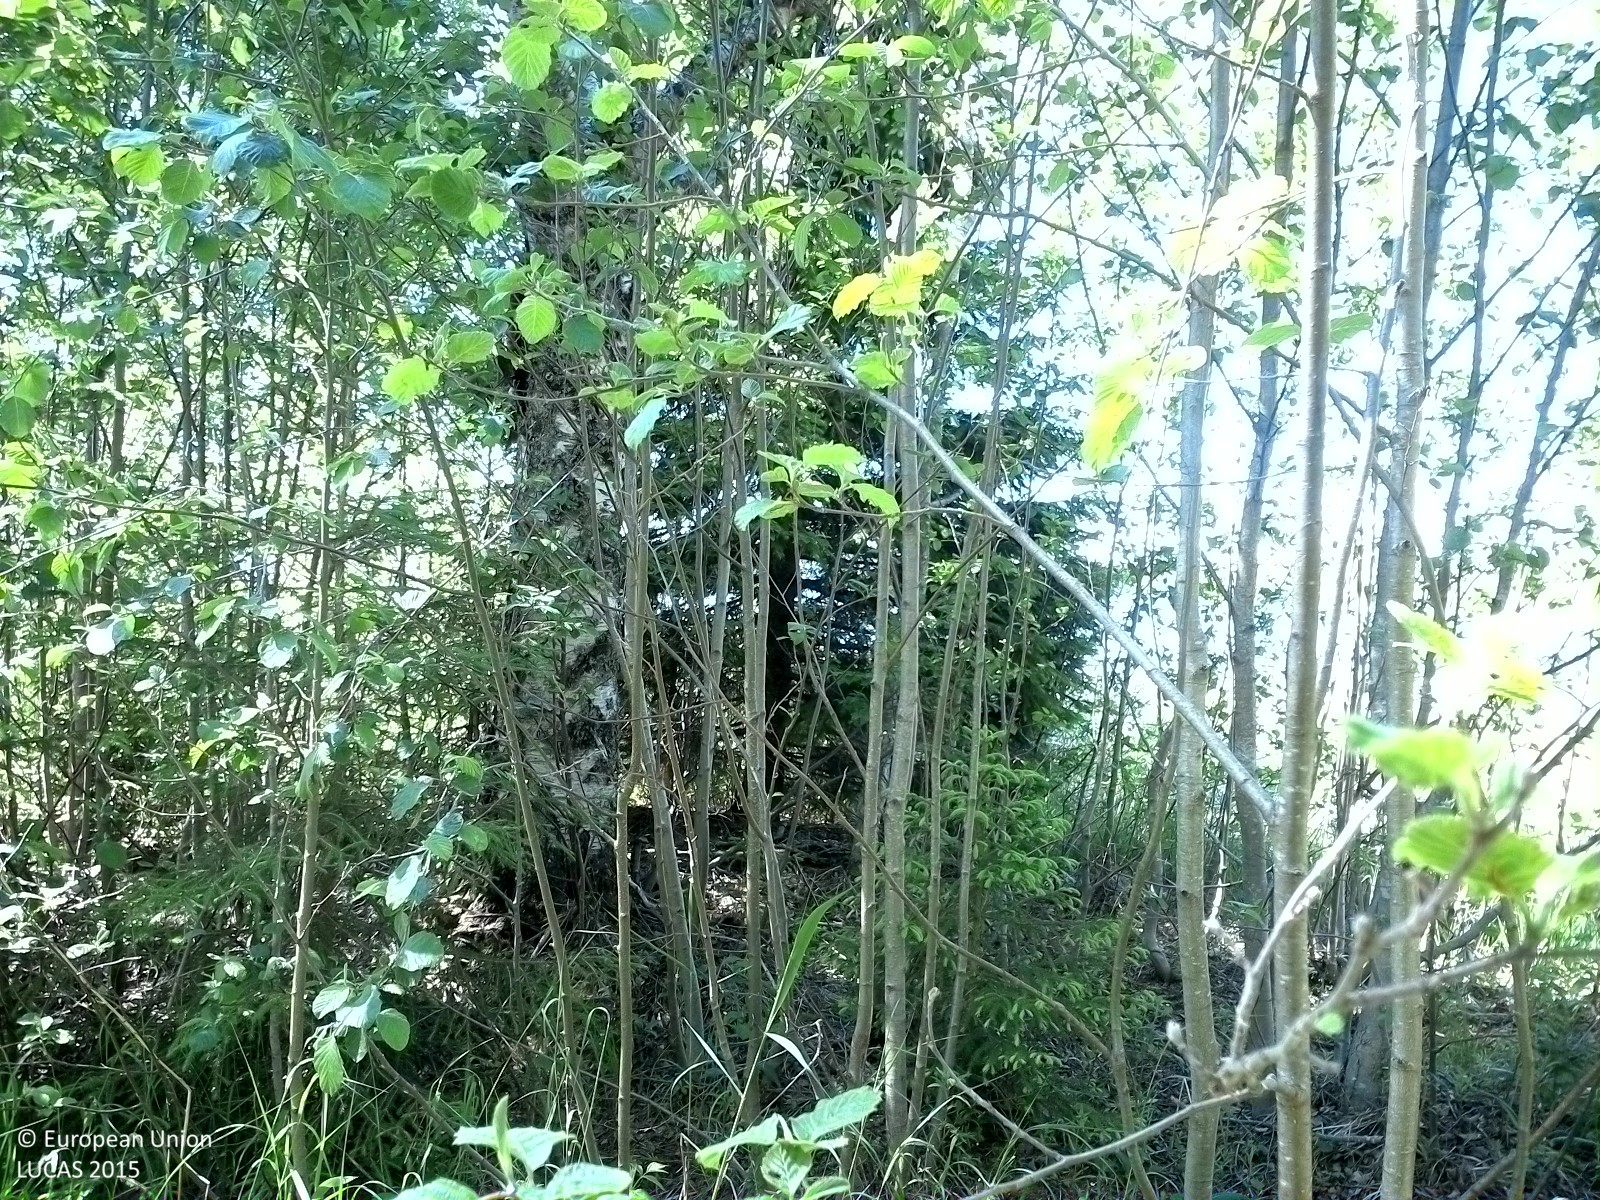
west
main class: Woodland
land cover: Spruce dominated mixed woodland
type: boreal forest
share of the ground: 50 - 75 %
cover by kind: broadleaved forest trees 40 %, herbaceous plants 40 %, coniferous forest trees 20 %
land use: Forestry
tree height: > 5 m
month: July
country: SE
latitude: 62.1334
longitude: 16.7893
